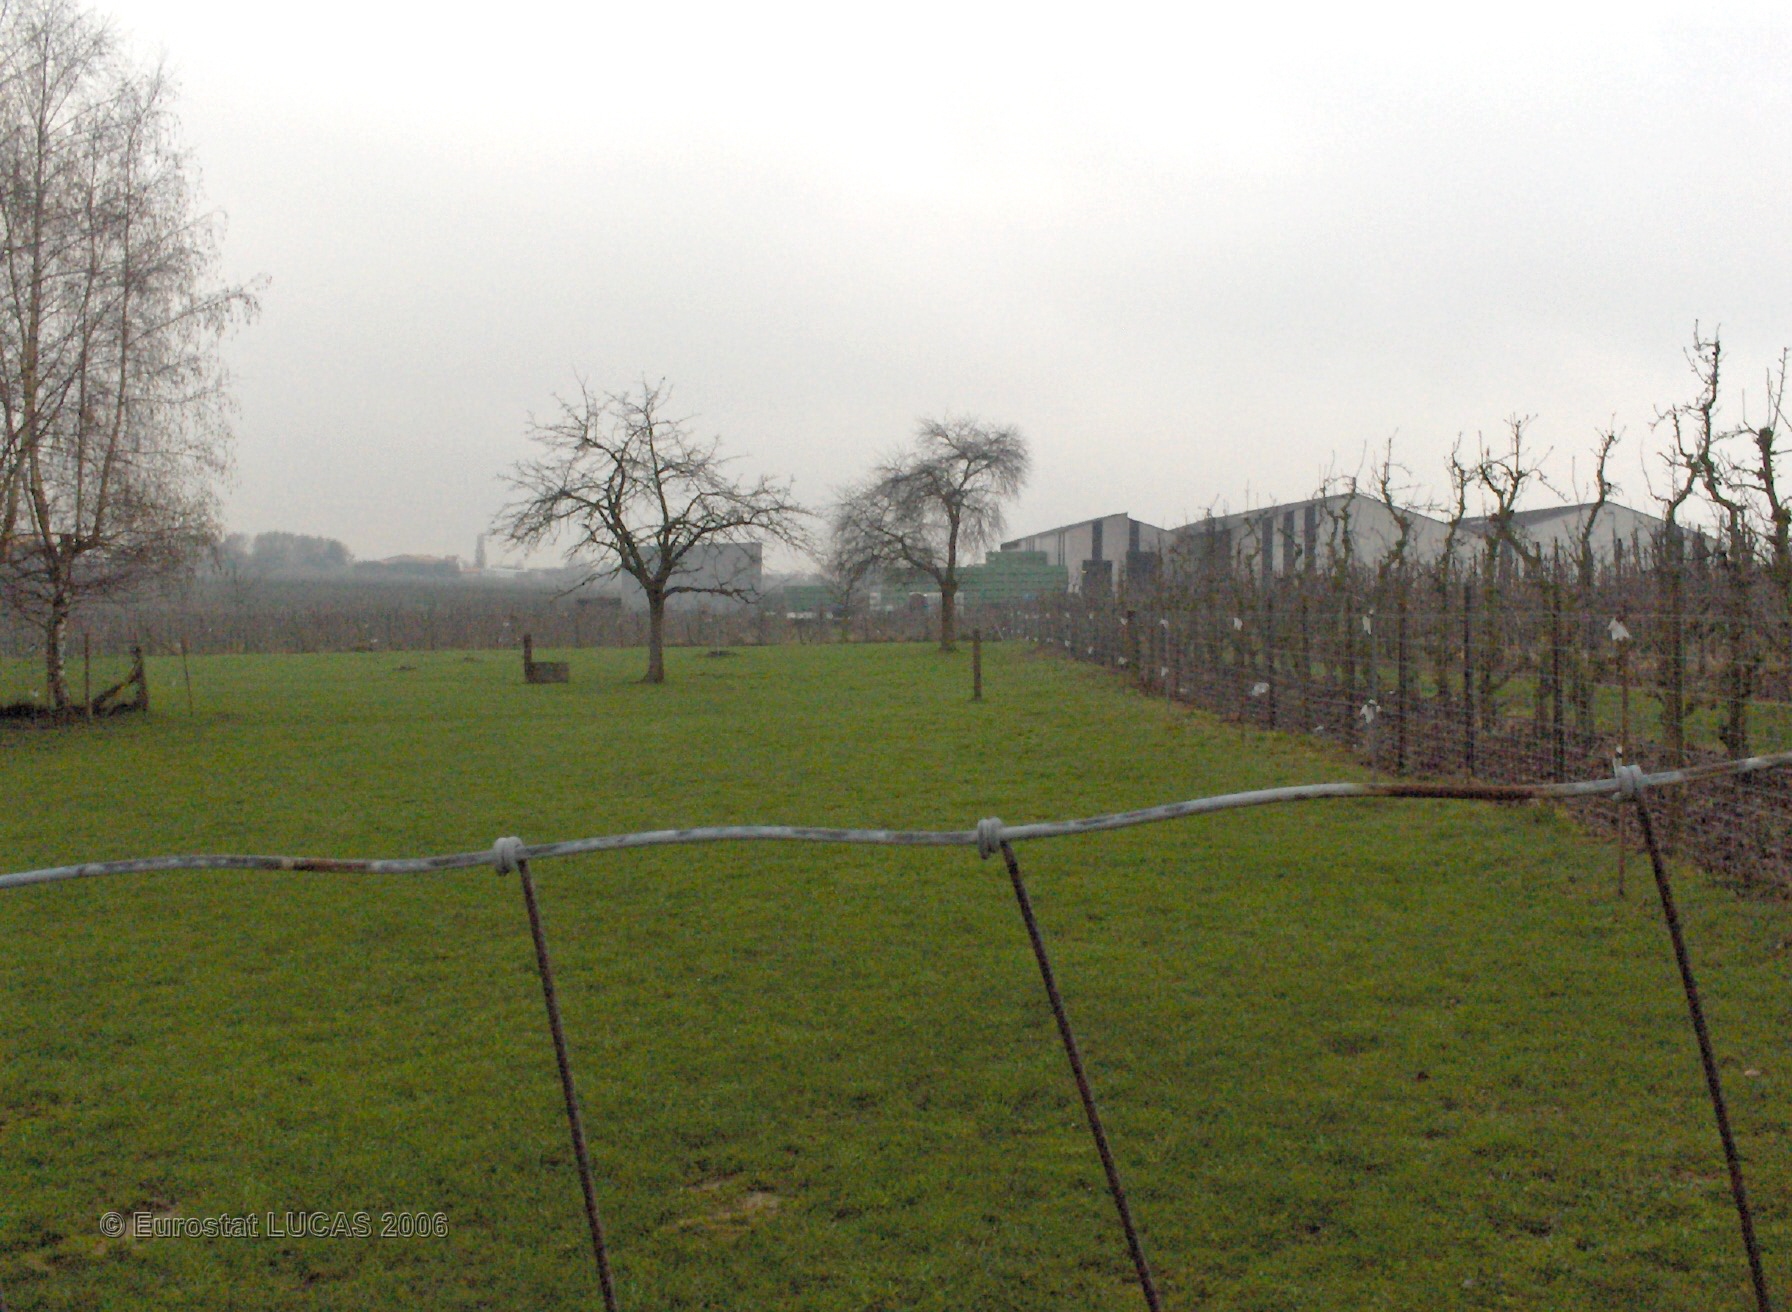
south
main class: Grassland
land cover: Grassland with sparse tree/shrub cover
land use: Agriculture (excluding fallow land and kitchen gardens)
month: April
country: BE
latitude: 50.8773
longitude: 5.2366
